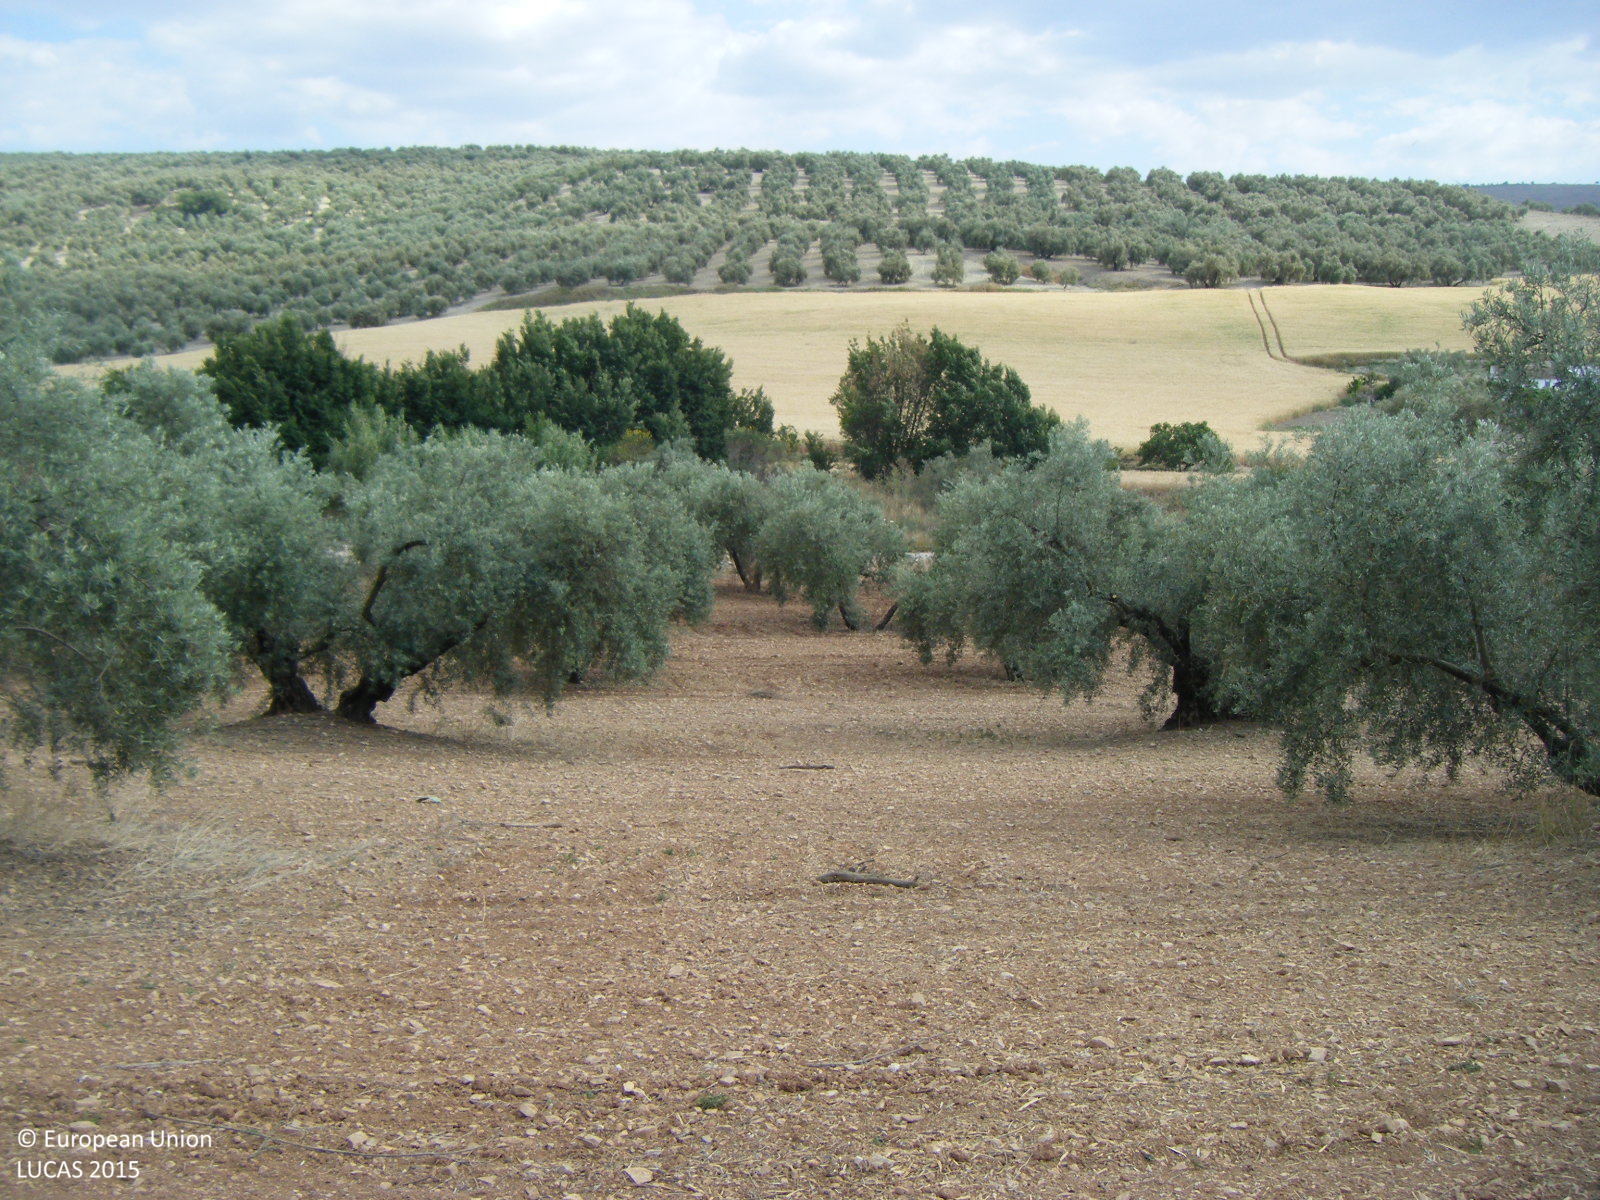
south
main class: Cropland
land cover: Olive groves
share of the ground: 25 - 50 %
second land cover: Other bare soil
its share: > 75 %
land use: Agriculture (excluding fallow land and kitchen gardens)
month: May
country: ES
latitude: 37.1924
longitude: -4.4293
